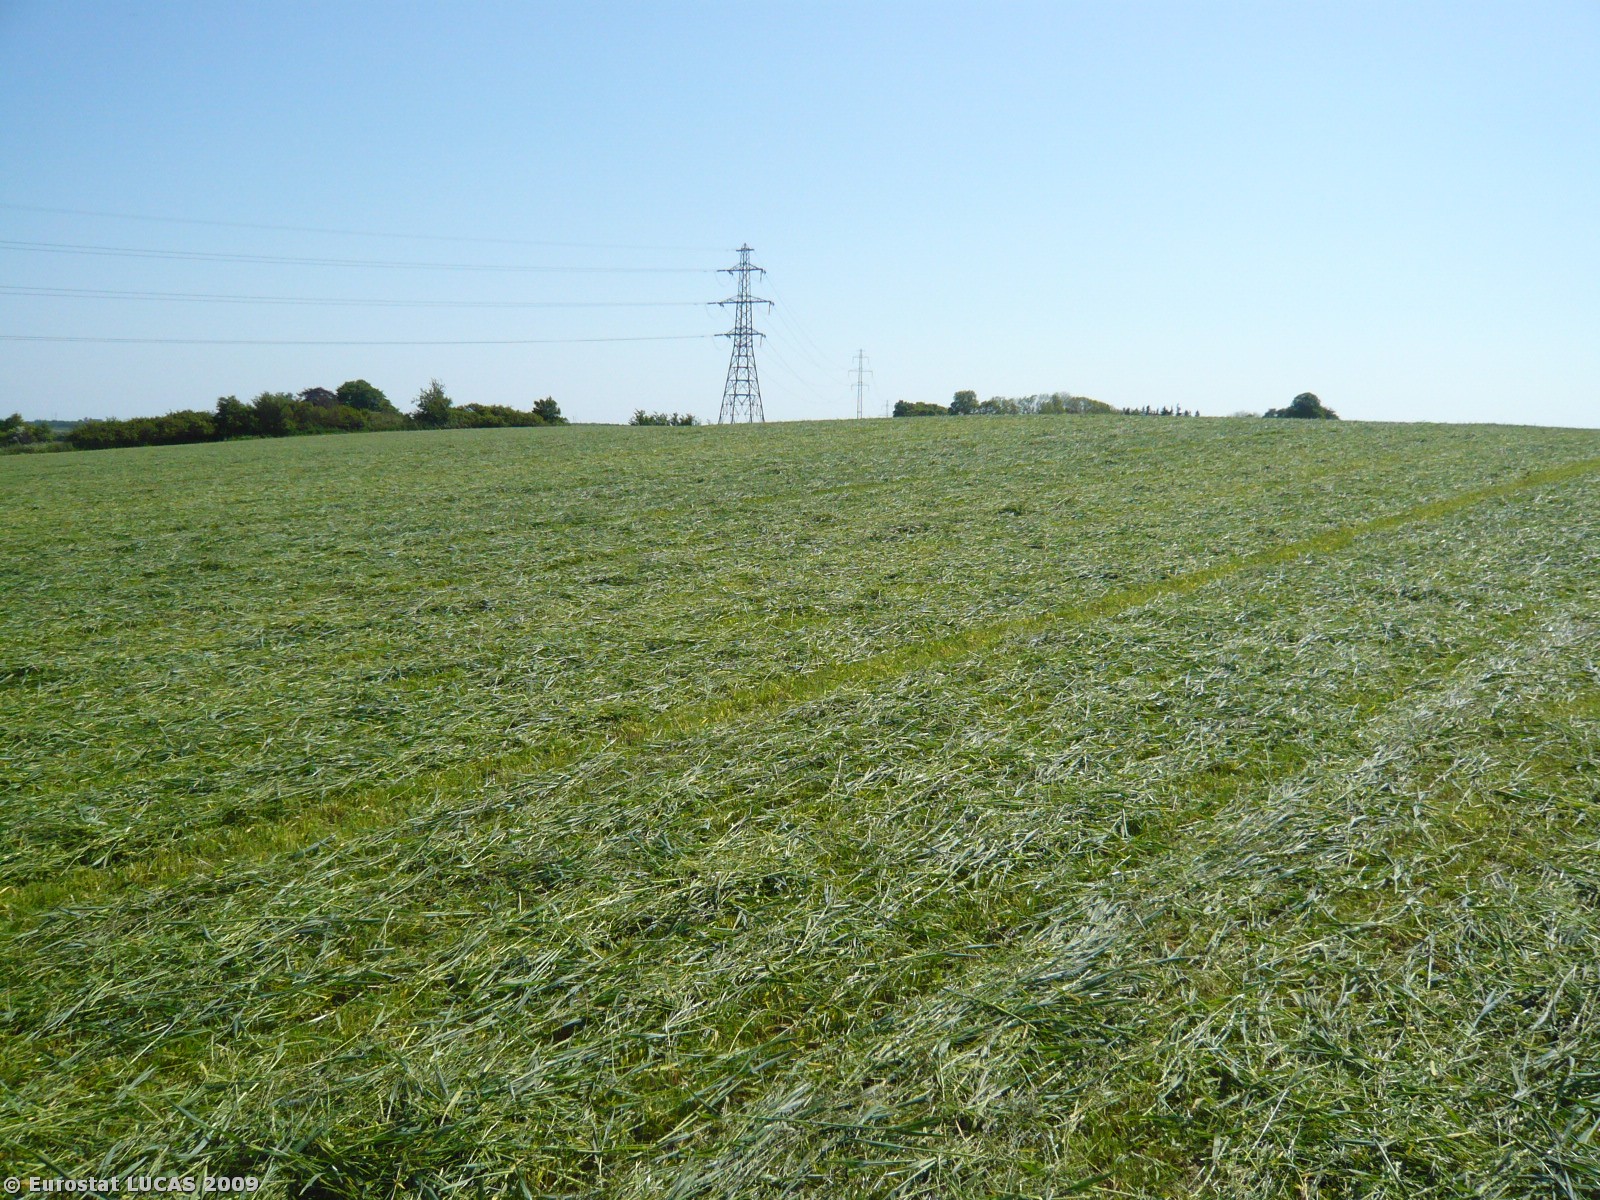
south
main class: Grassland
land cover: Grassland without tree/shrub cover
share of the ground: > 75 %
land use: Agriculture (excluding fallow land and kitchen gardens)
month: May
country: DK
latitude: 55.2774
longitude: 11.7145
